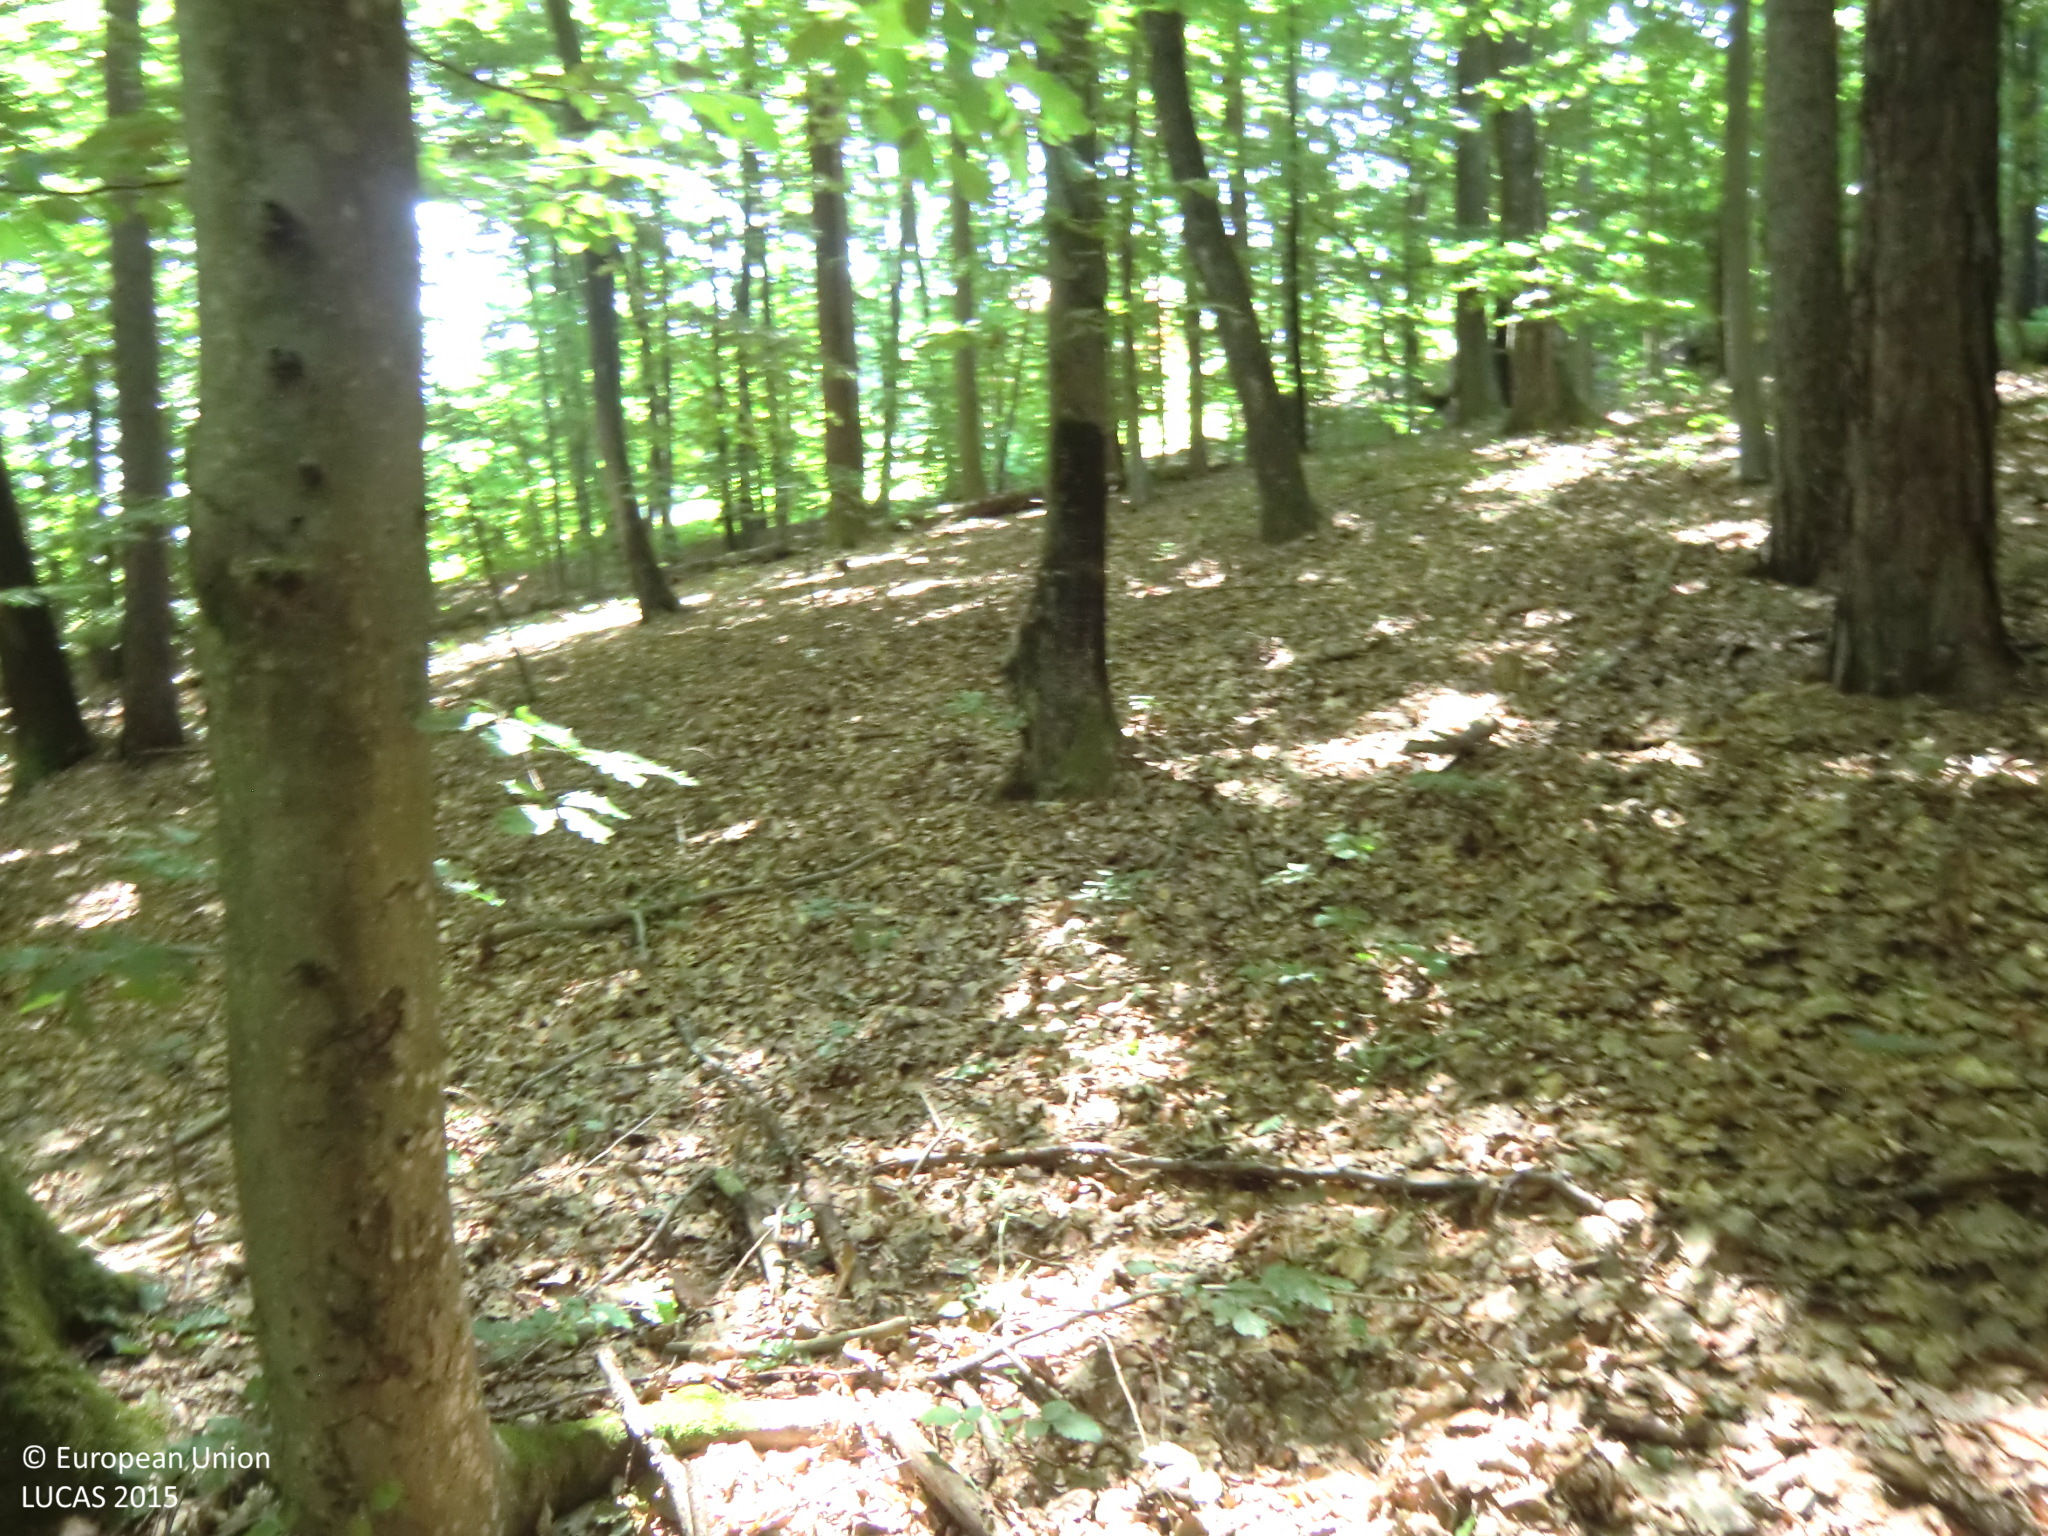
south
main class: Woodland
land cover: Pine dominated mixed woodland
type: hemiboreal forest and nemoral coniferous forest and mixed broadleaved-coniferous forest
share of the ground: > 75 %
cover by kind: broadleaved forest trees 65 %, coniferous forest trees 25 %, unconsolidated bare surface 10 %
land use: Forestry
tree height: > 5 m
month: July
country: AT
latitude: 47.0670
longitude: 15.6756
